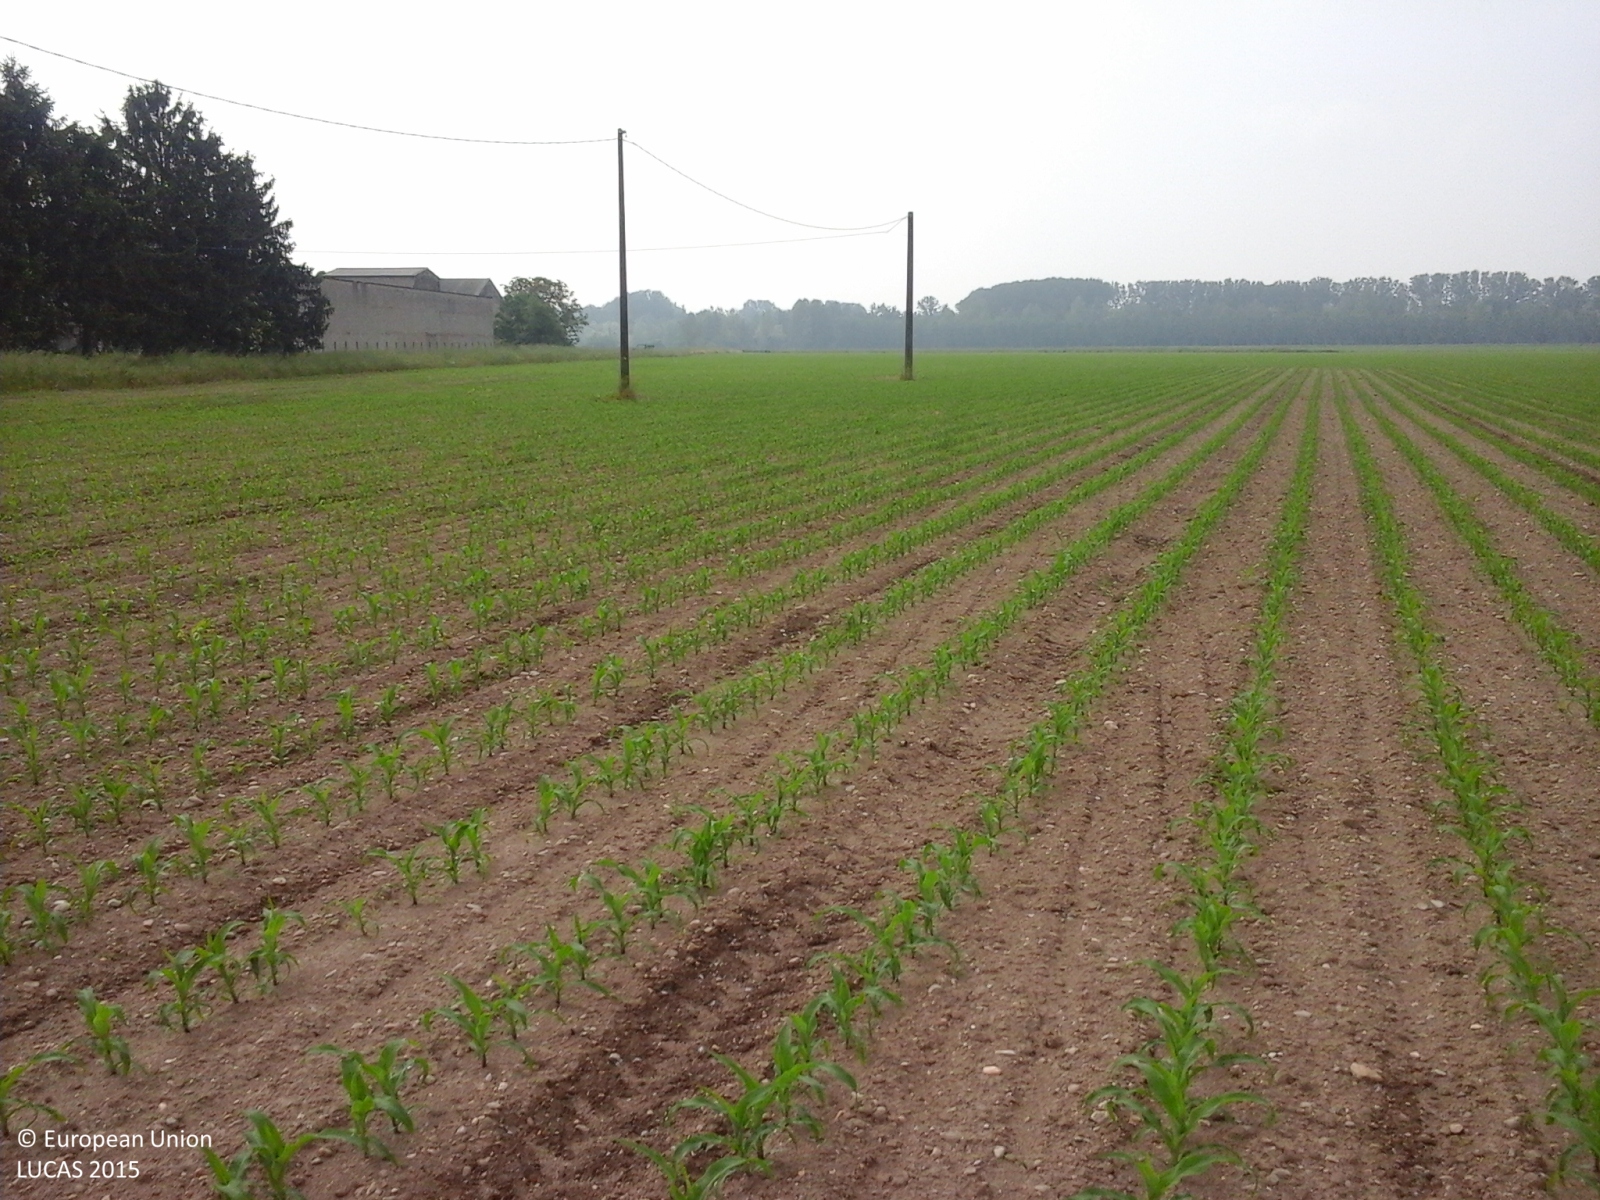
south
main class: Cropland
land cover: Maize
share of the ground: 10 - 25 %
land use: Agriculture (excluding fallow land and kitchen gardens)
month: May
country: IT
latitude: 45.3421
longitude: 9.8599
